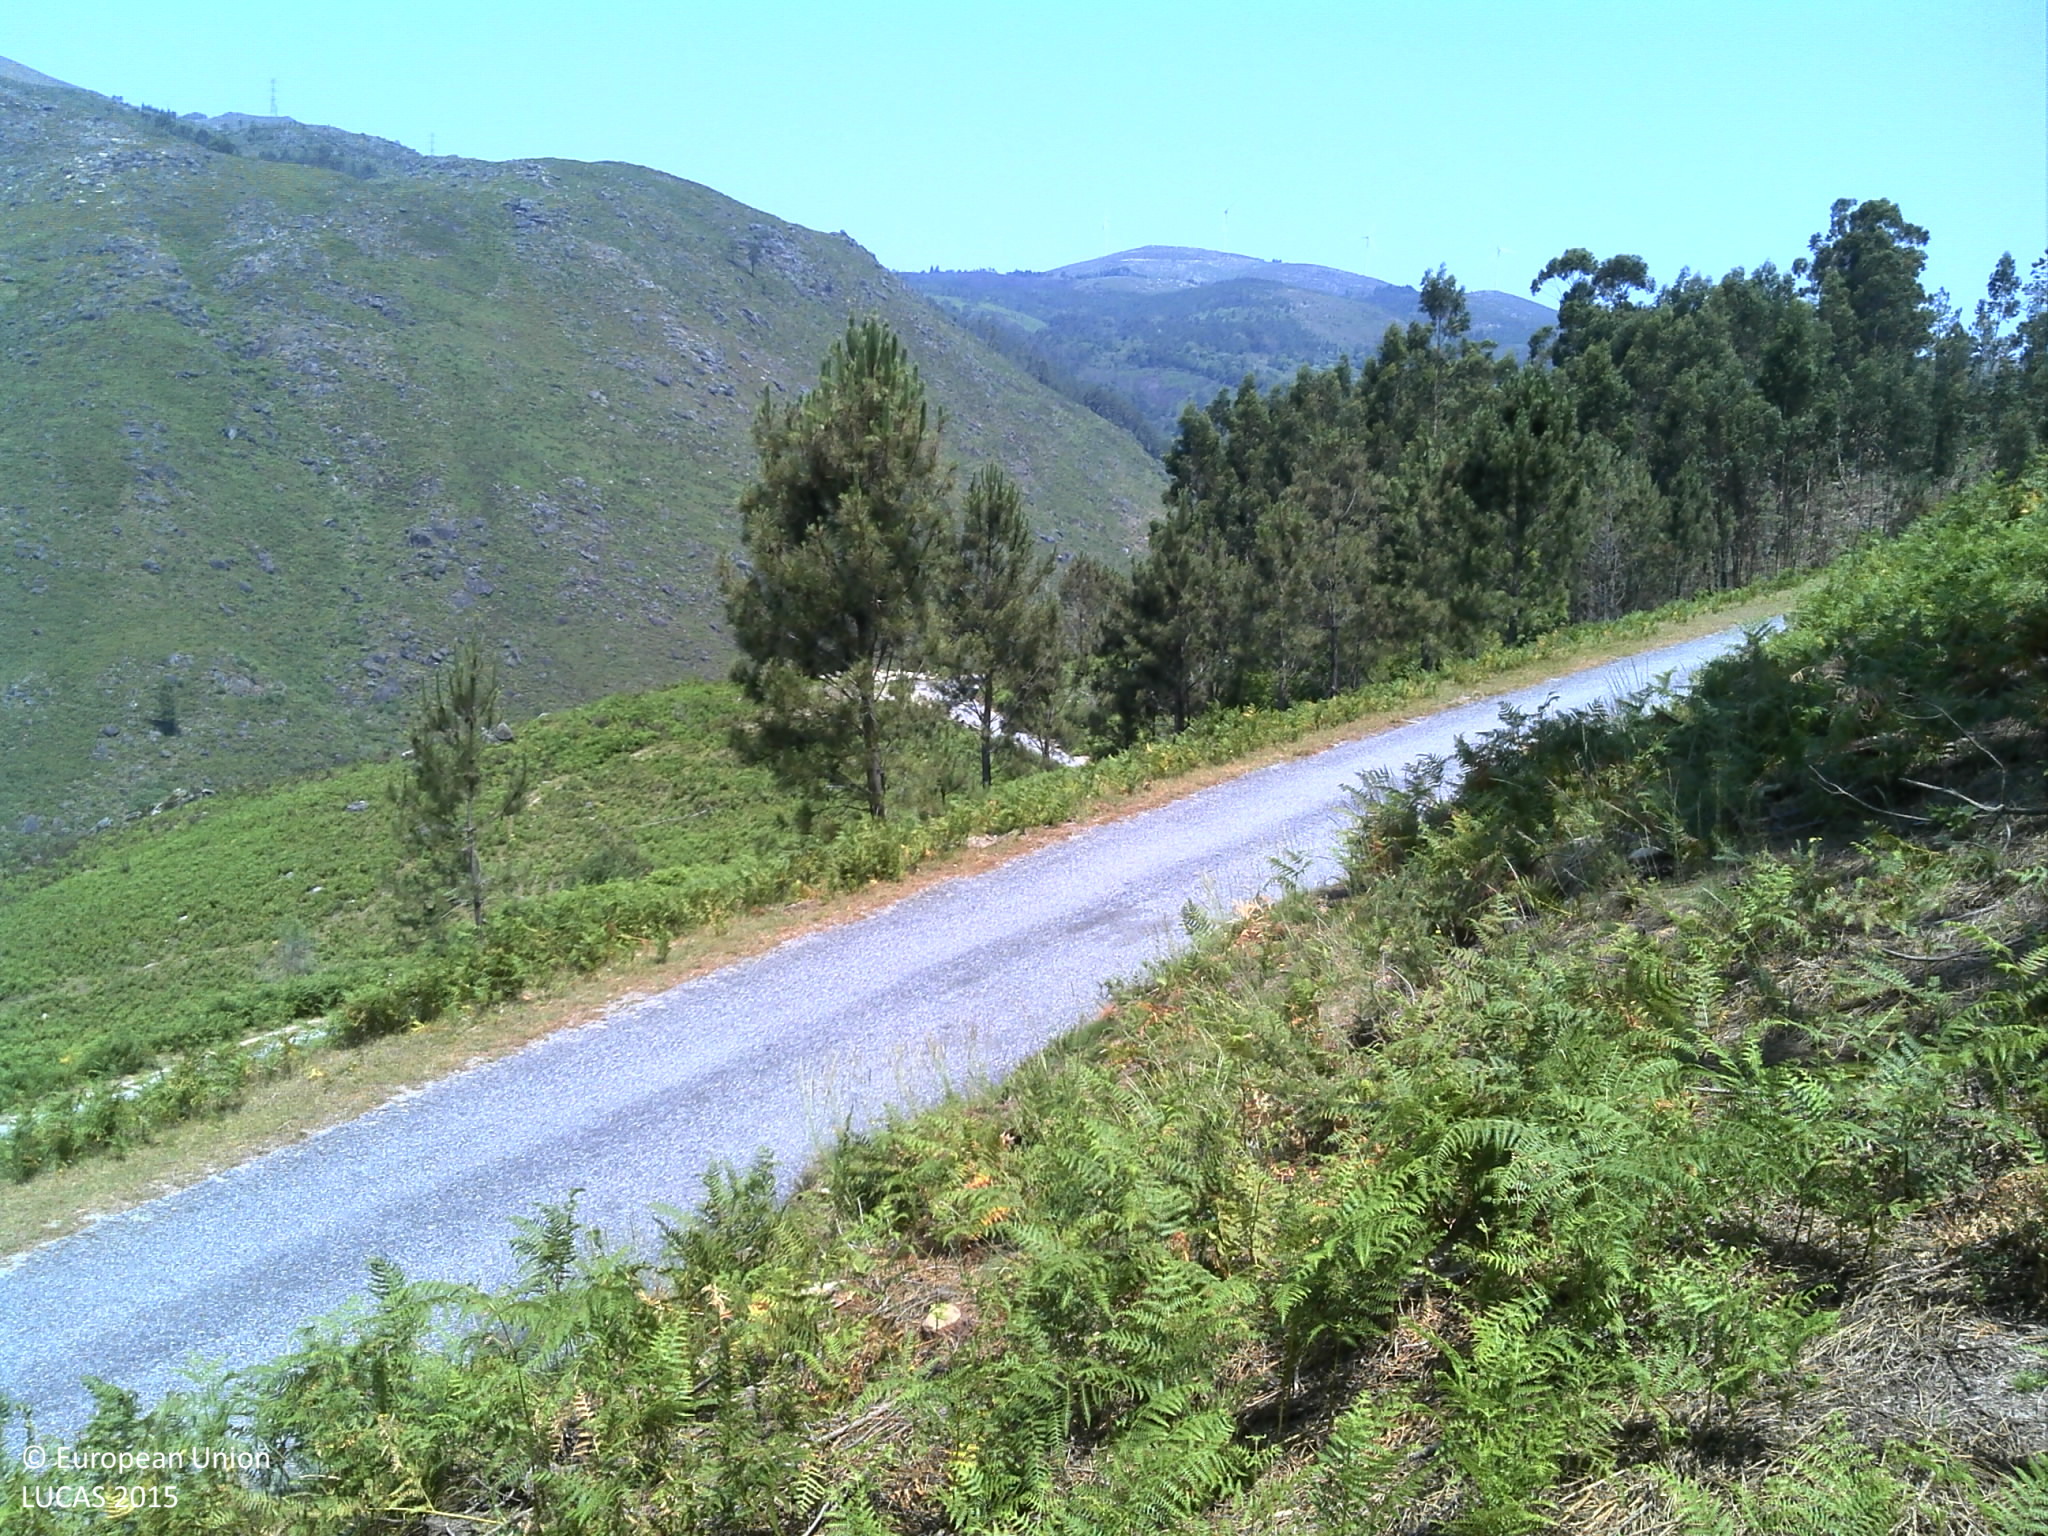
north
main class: Woodland
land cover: Pine dominated coniferous woodland
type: coniferous forest of the mediterranean region
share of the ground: 25 - 50 %
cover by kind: coniferous forest trees 50 %, consolidated bare surface 30 %, shrubs 20 %
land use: Forestry
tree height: > 5 m
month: June
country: PT
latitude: 41.9467
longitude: -8.4108
